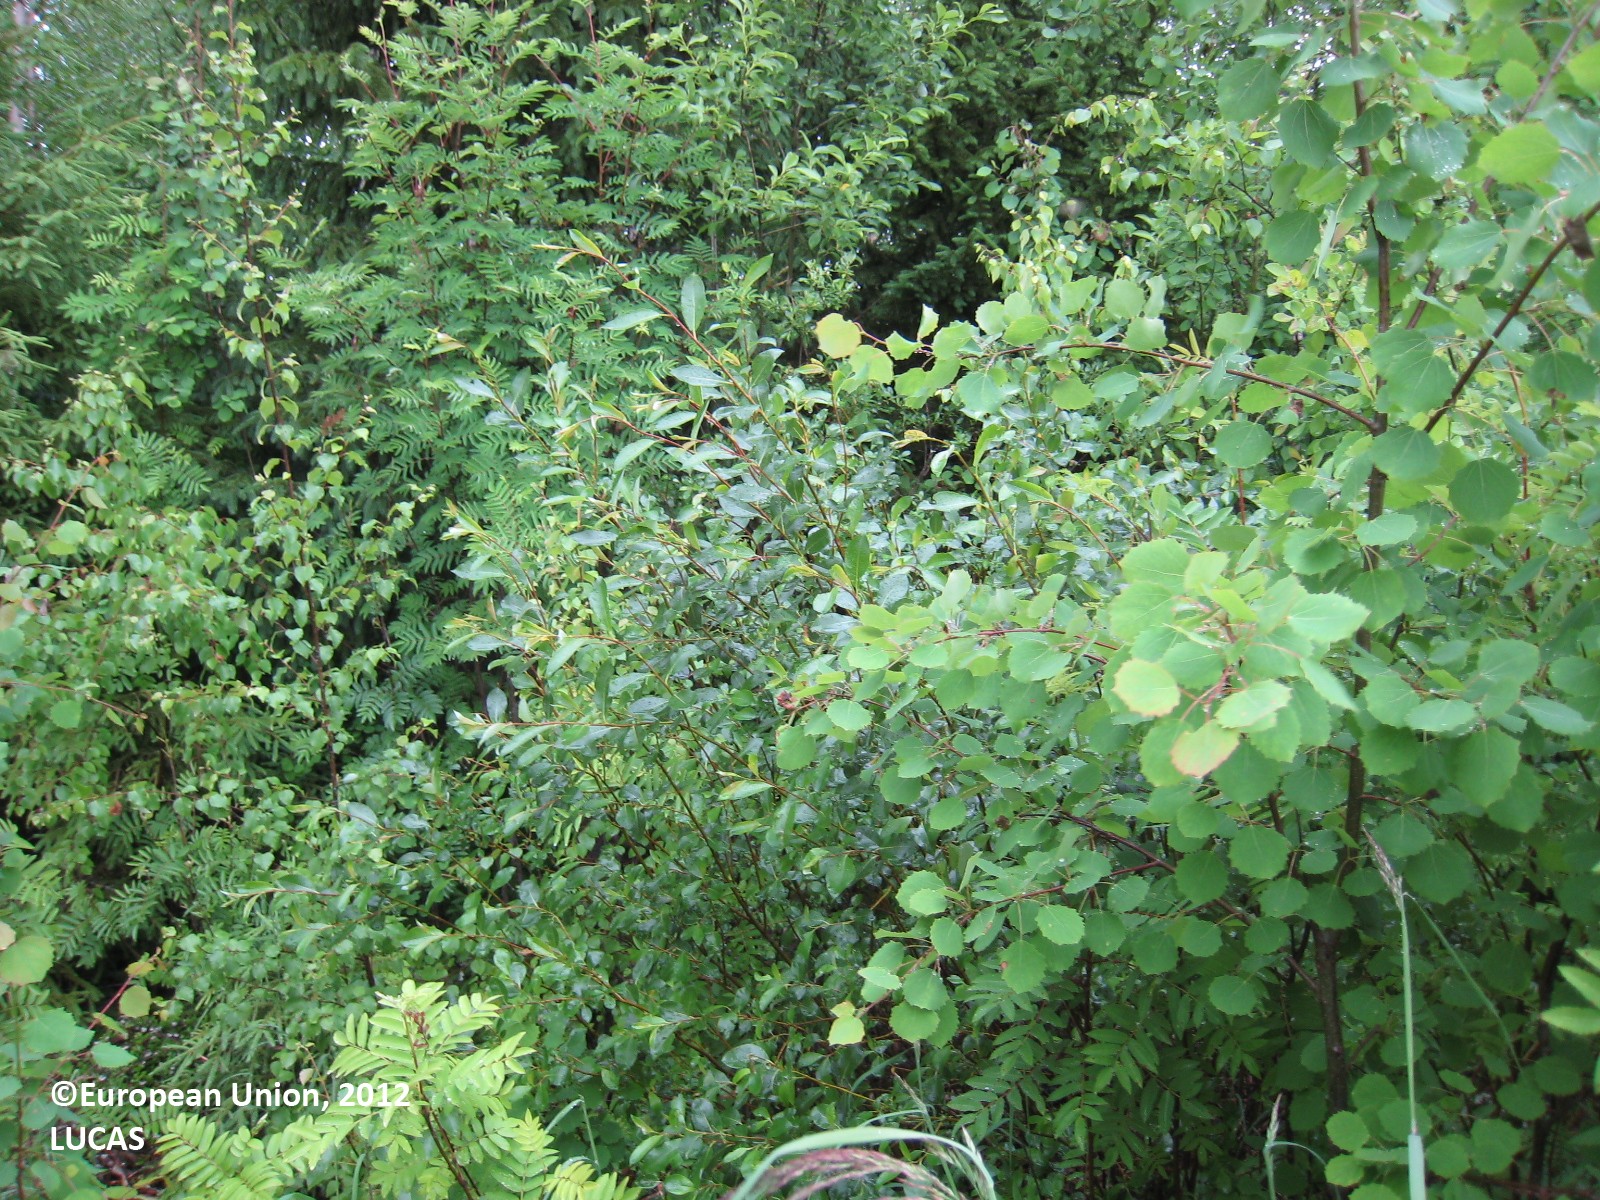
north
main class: Woodland
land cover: Broadleaved woodland
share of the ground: > 75 %
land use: Energy production
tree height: < 5 m
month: June
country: FI
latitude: 62.3004
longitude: 26.3533
